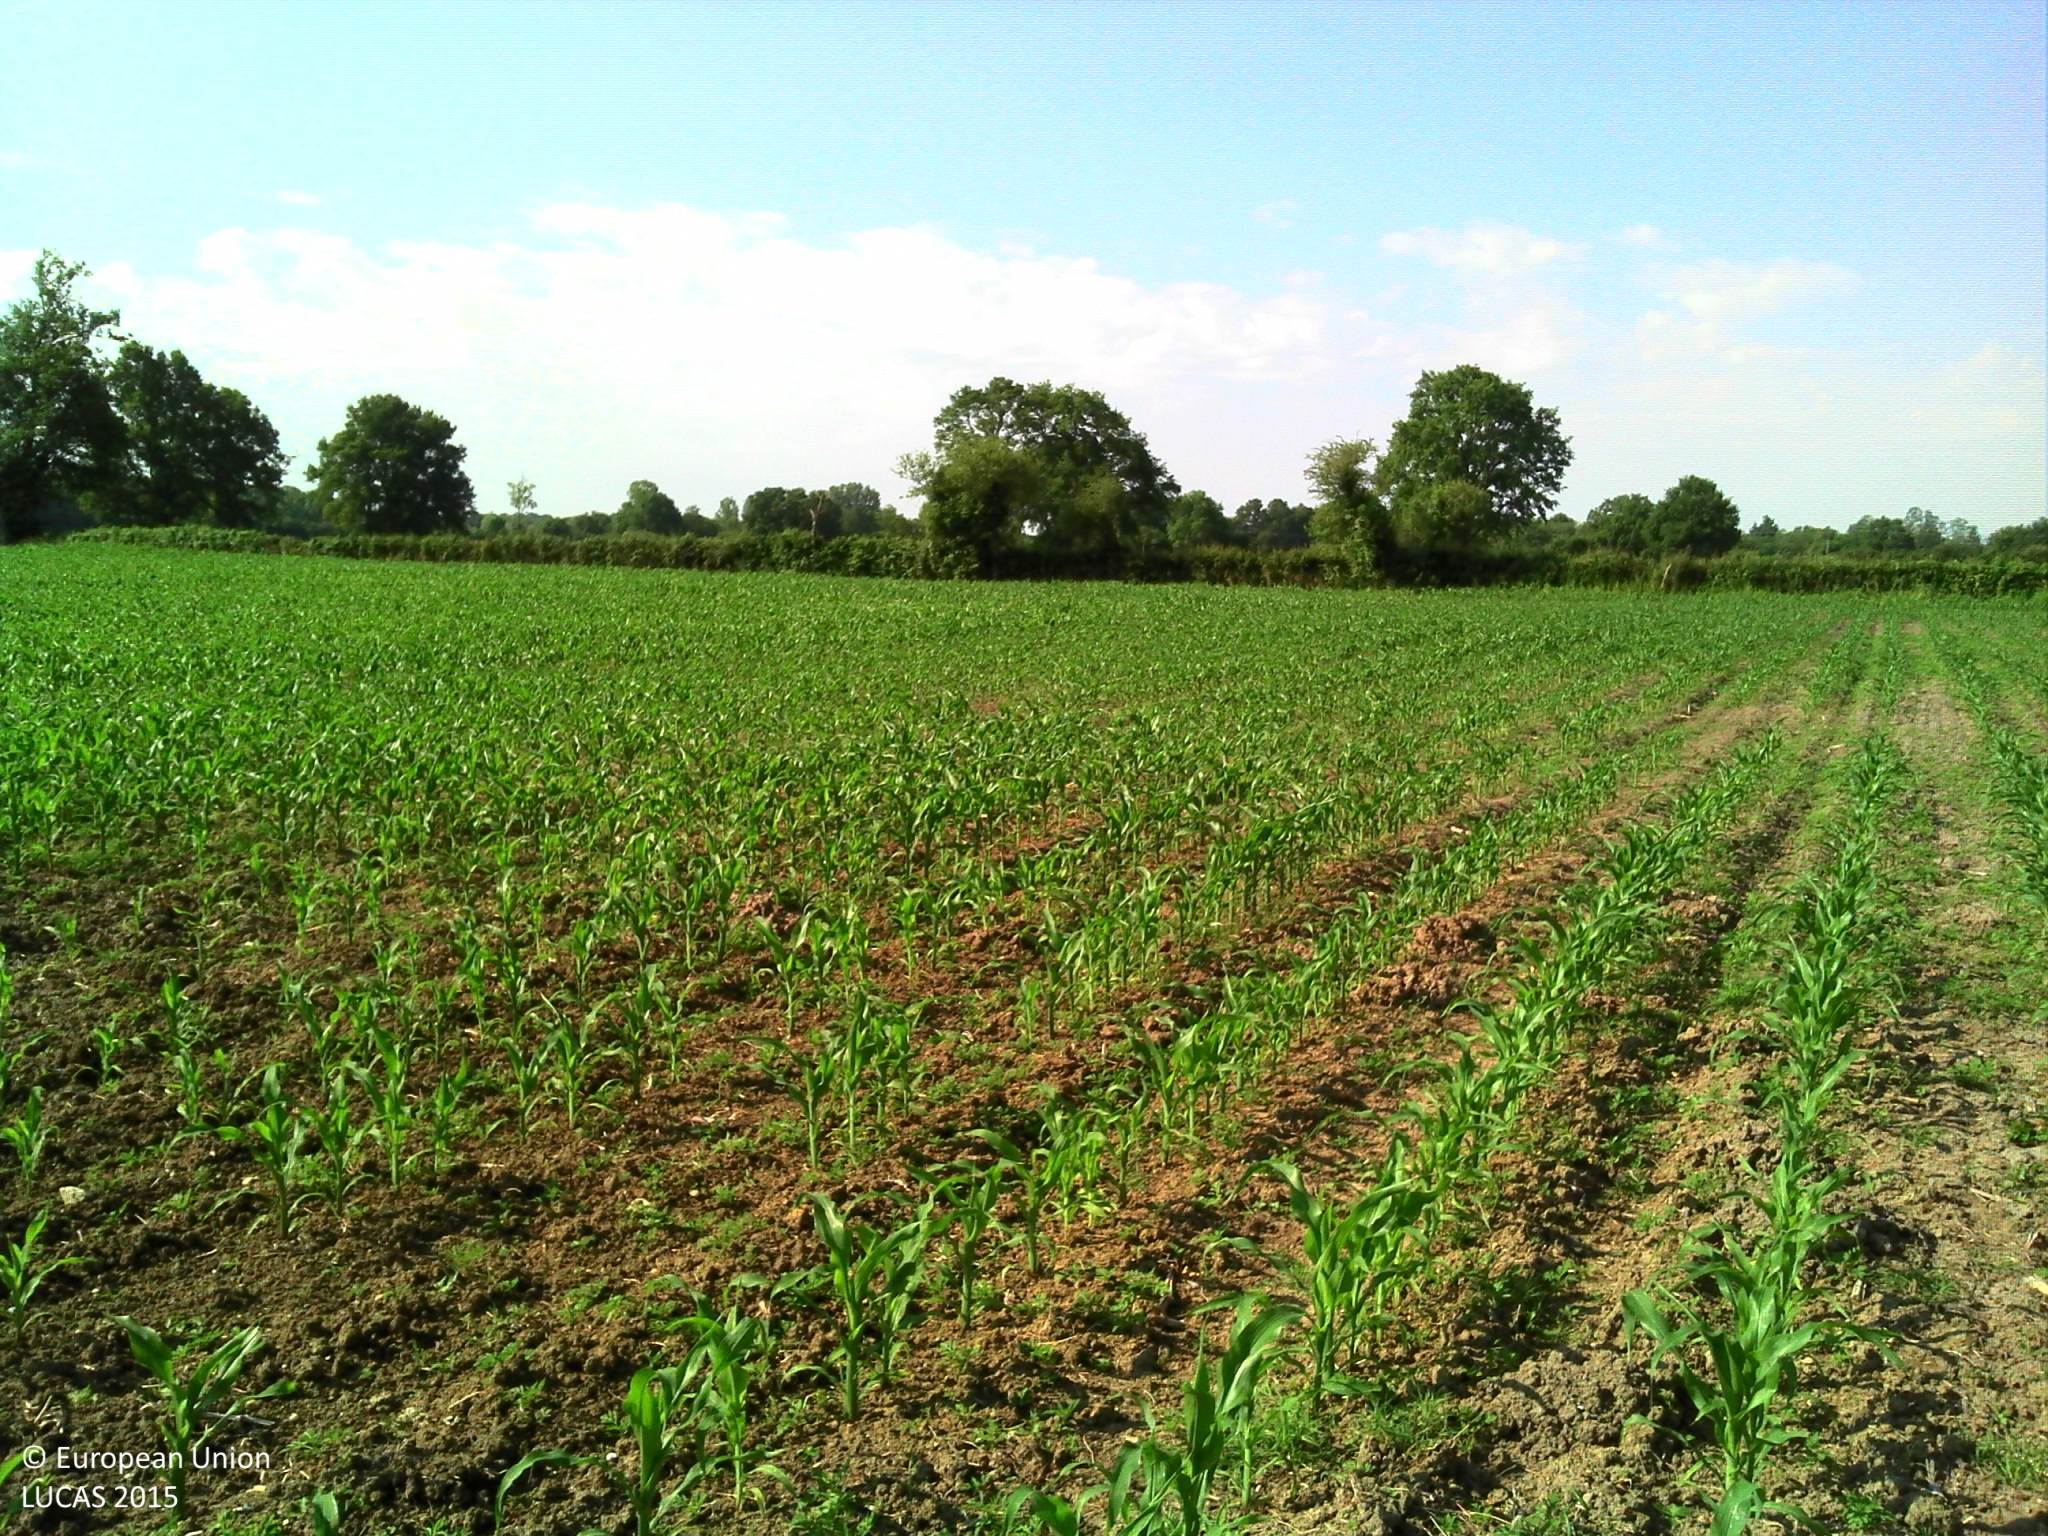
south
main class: Cropland
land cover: Maize
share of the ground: 50 - 75 %
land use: Agriculture (excluding fallow land and kitchen gardens)
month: June
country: FR
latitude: 46.7724
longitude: 2.7271
